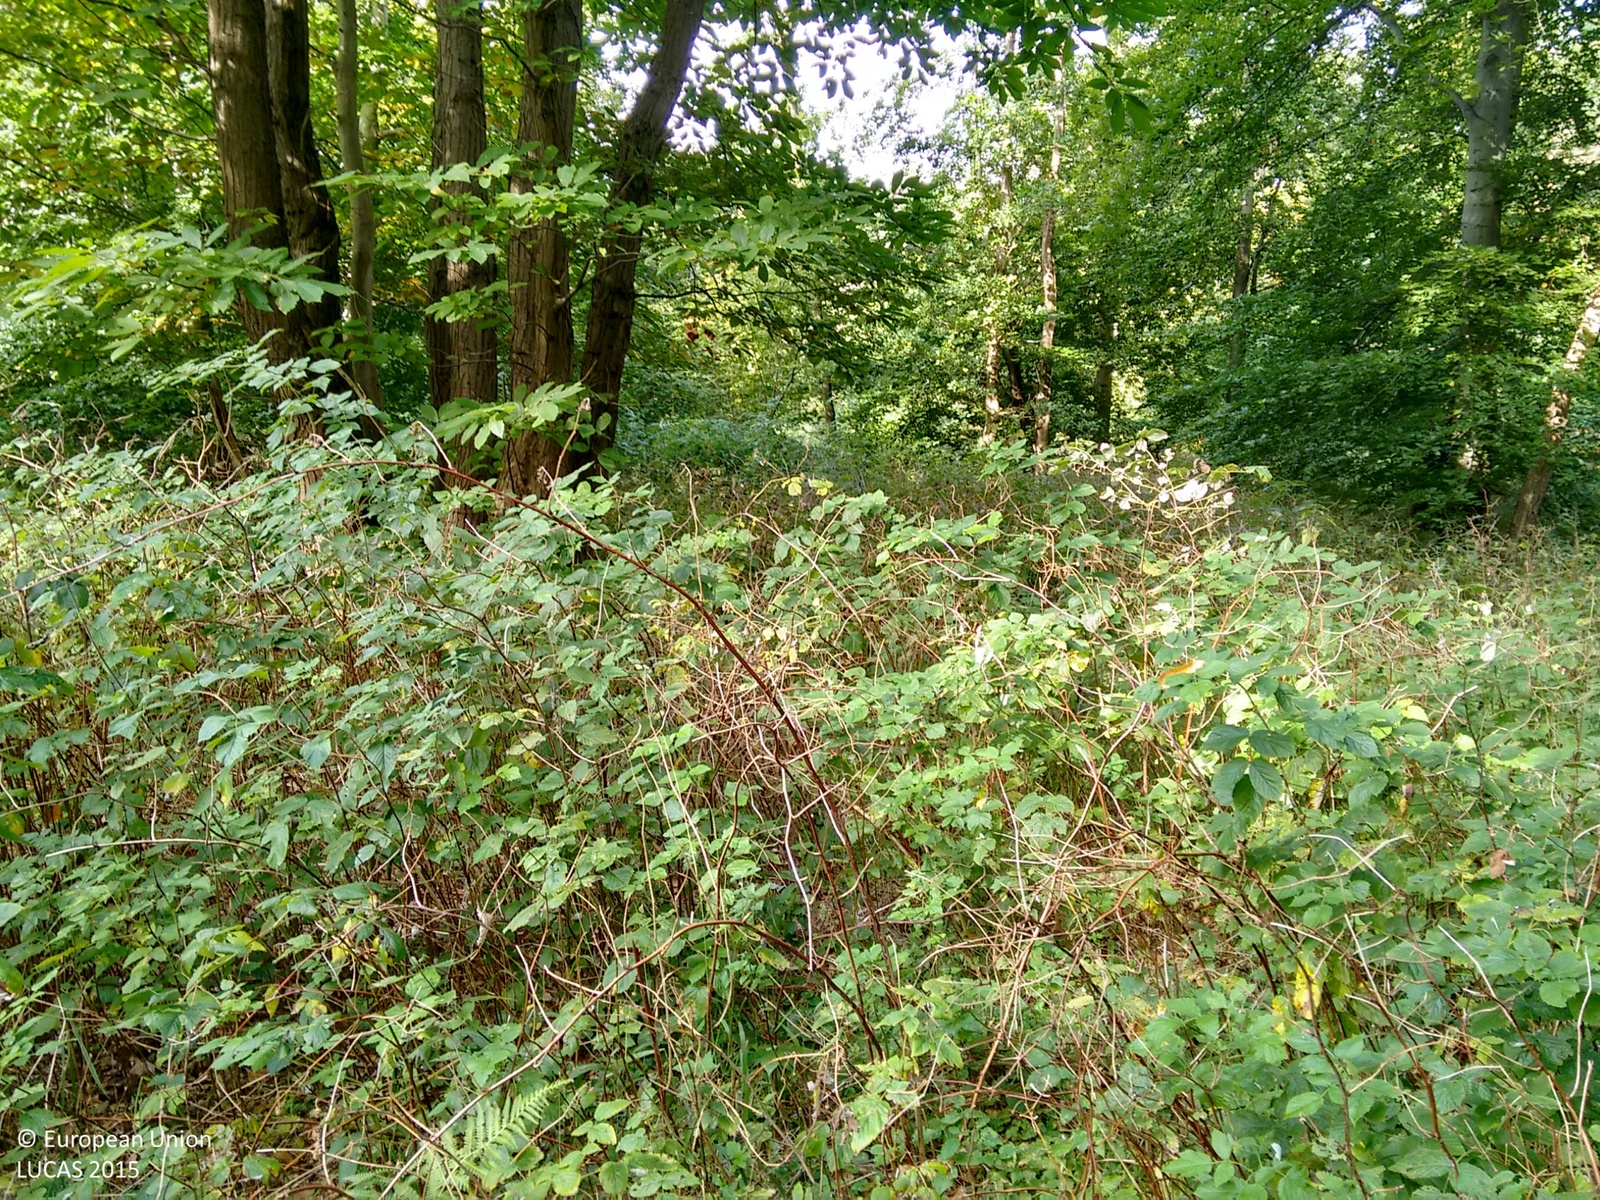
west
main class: Woodland
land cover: Broadleaved woodland
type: mesophytic deciduous forest
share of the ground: > 75 %
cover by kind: broadleaved forest trees 100 %
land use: Forestry
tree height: > 5 m
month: September
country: GB
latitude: 52.4256
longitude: 0.9025
